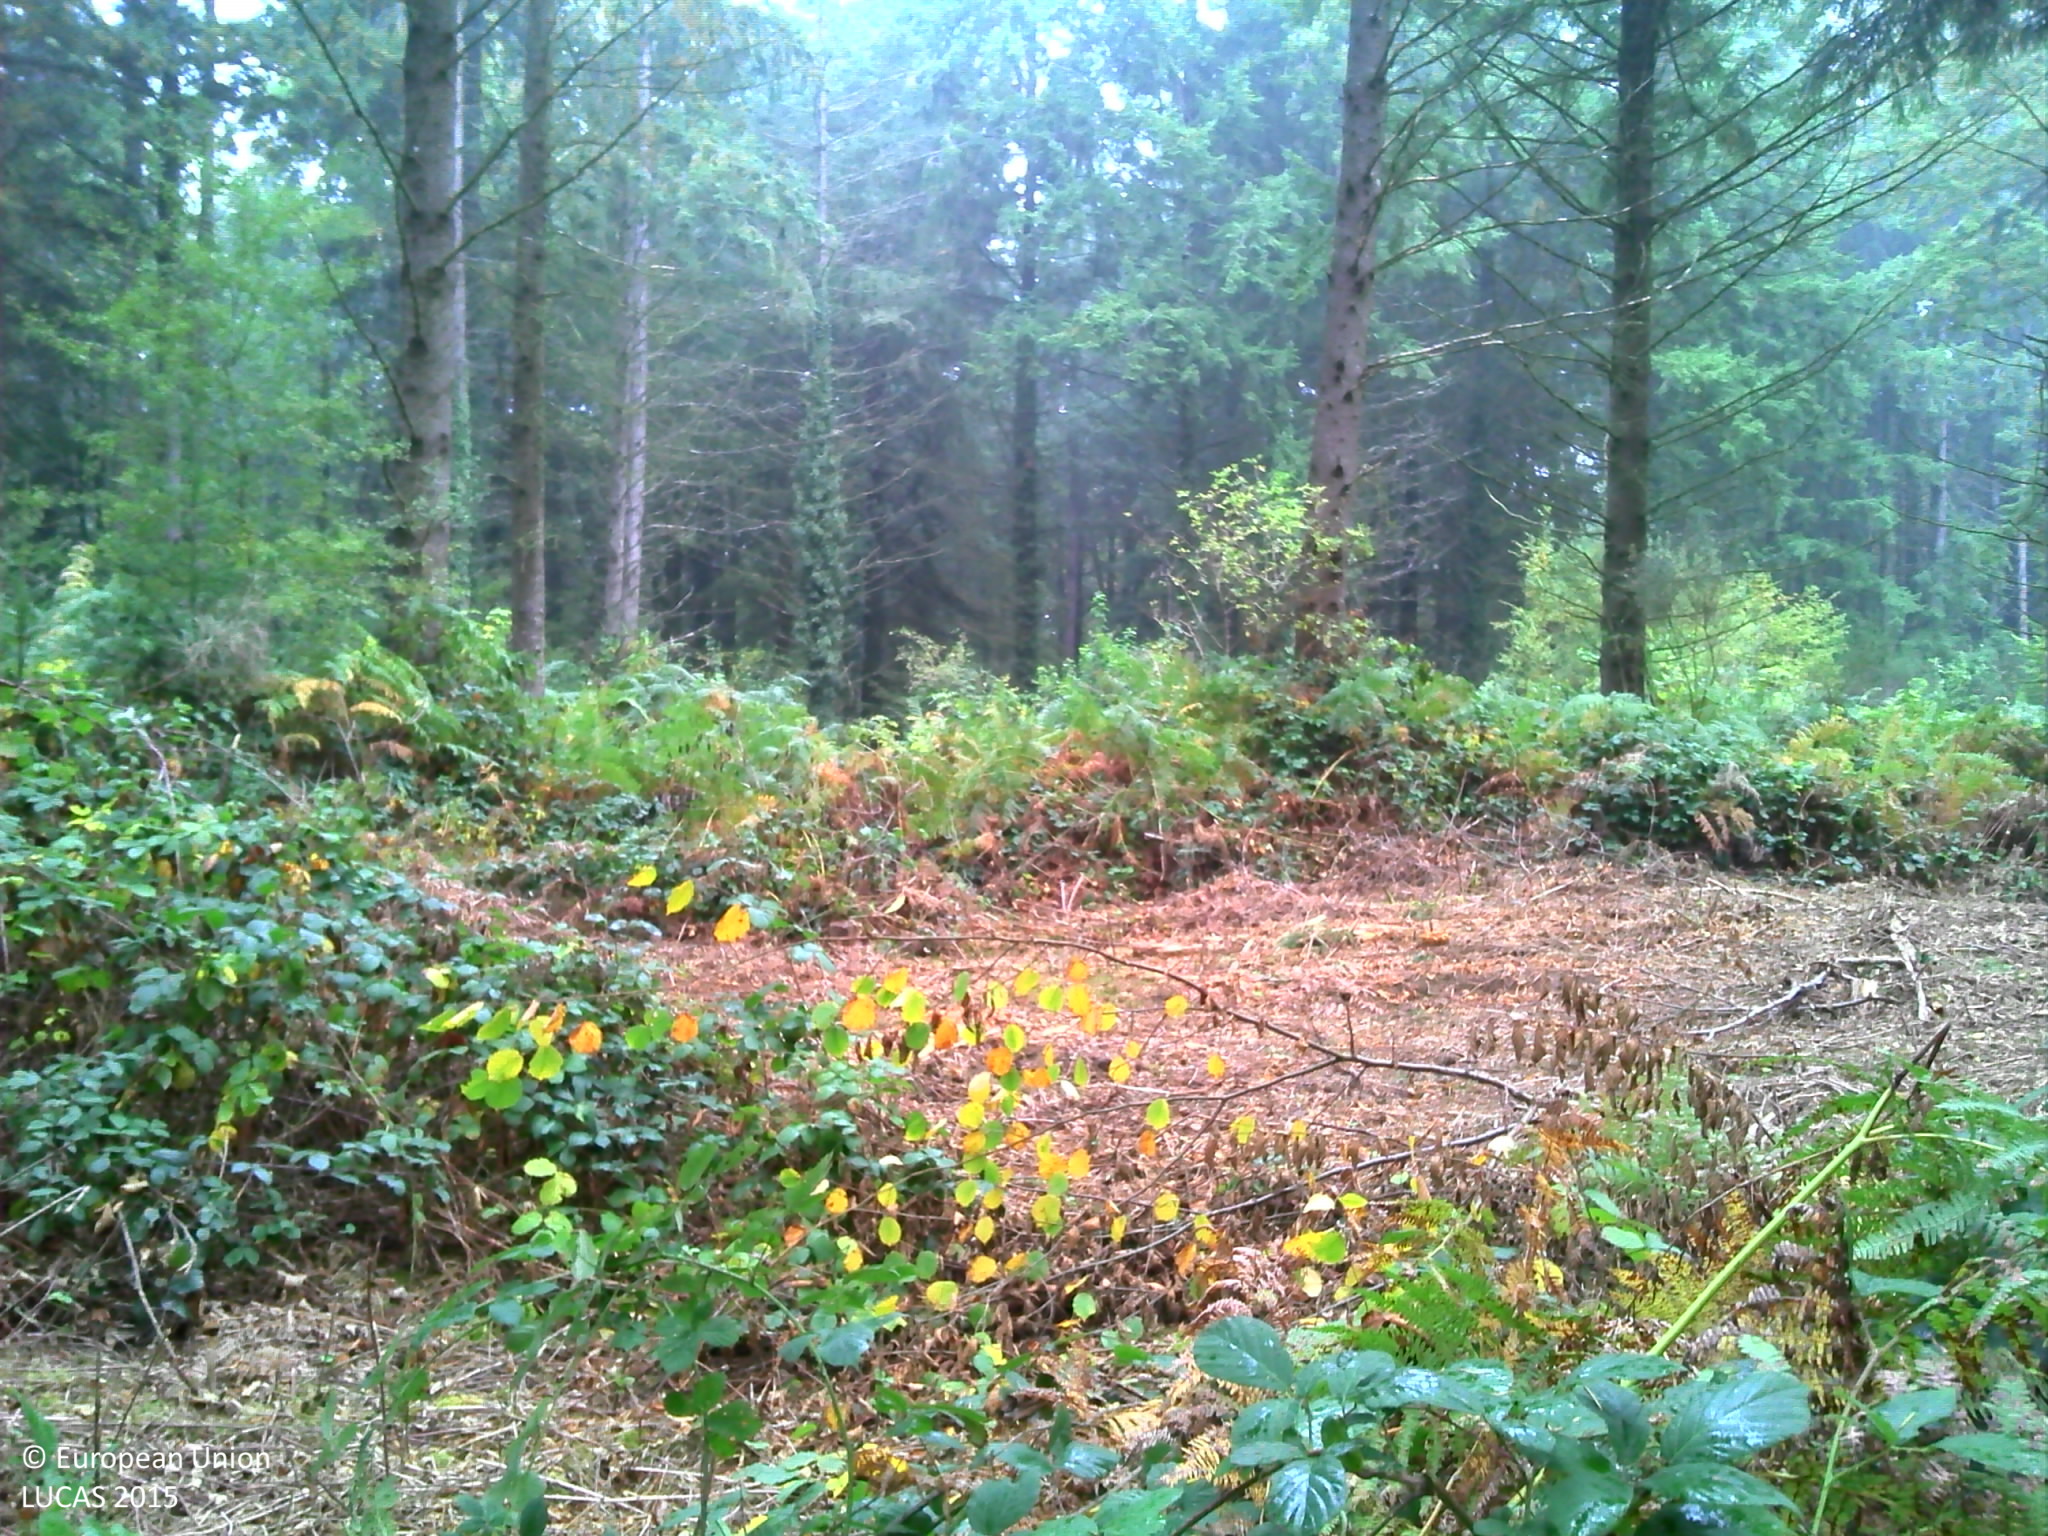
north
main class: Woodland
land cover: Other coniferous woodland
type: exotic forest
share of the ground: 50 - 75 %
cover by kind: coniferous forest trees 65 %, shrubs 20 %, broadleaved forest trees 5 %, herbaceous plants 5 %, lichens and mosses 5 %
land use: Forestry
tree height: > 5 m
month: October
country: FR
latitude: 46.1974
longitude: 2.7793
